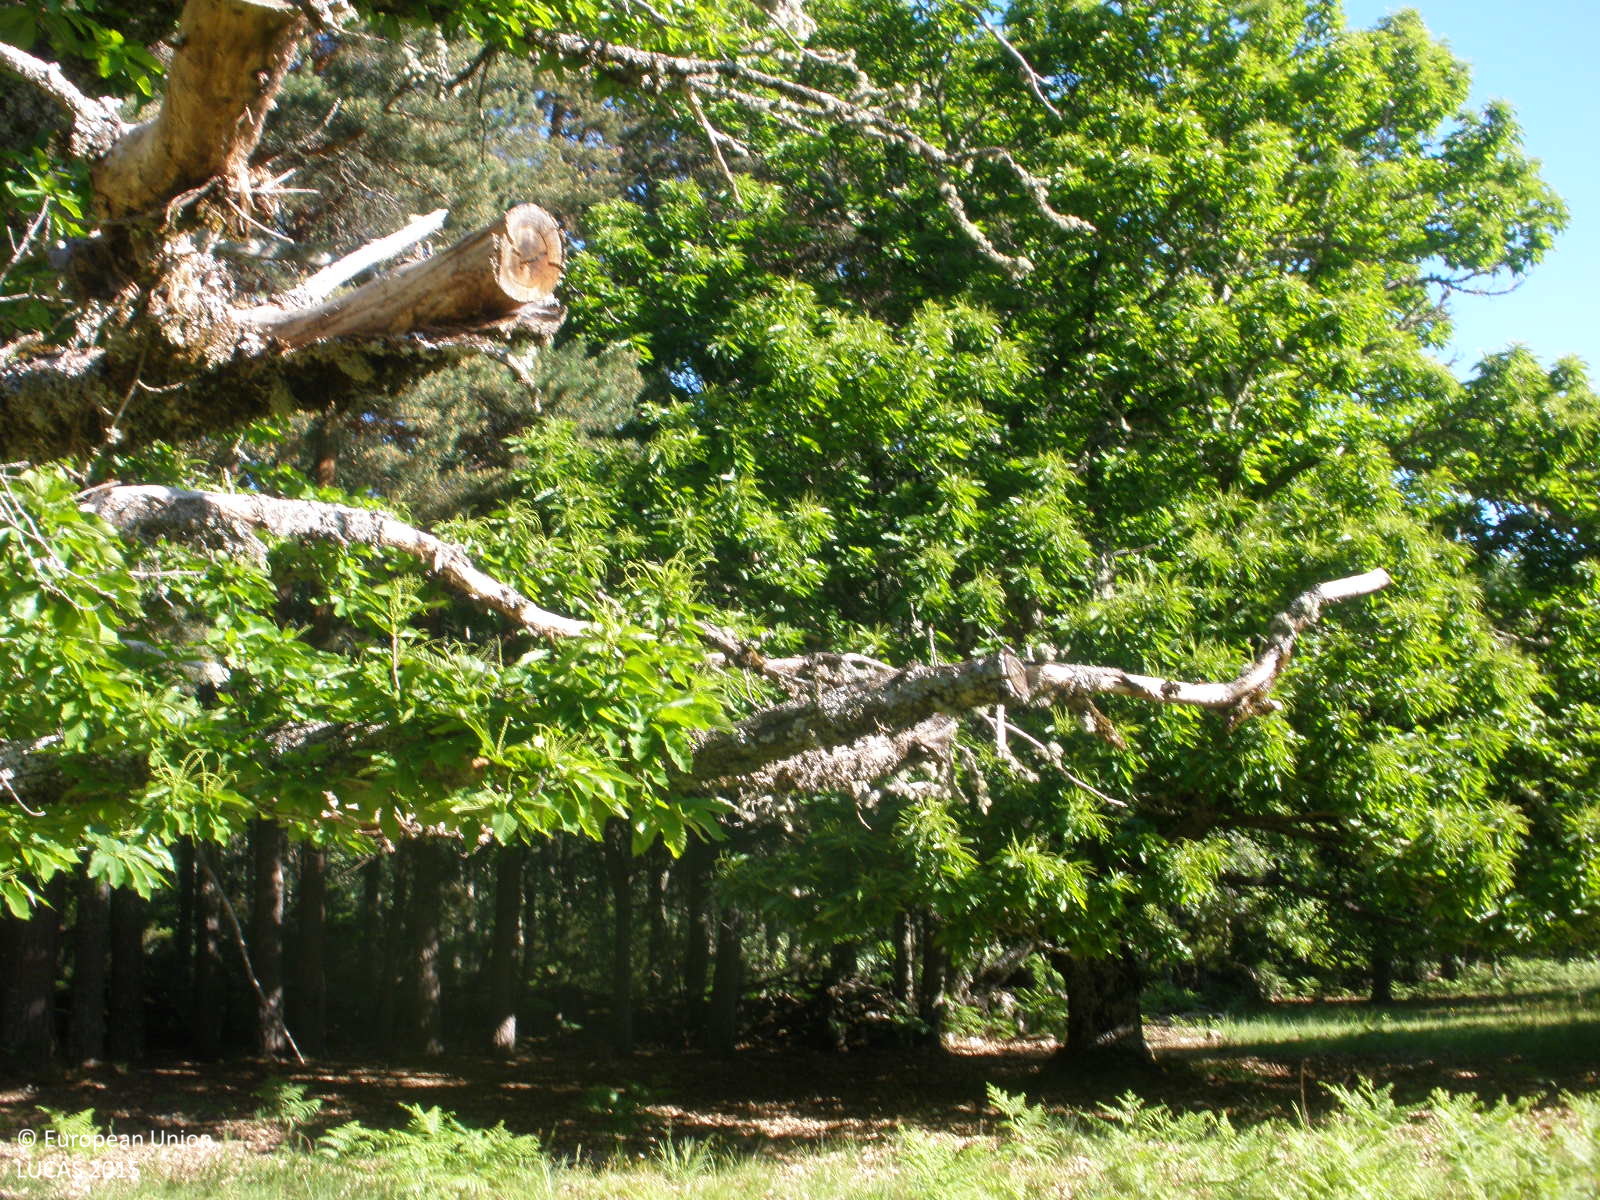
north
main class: Grassland
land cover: Grassland with sparse tree/shrub cover
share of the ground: > 75 %
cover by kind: herbaceous plants 95 %, broadleaved forest trees 5 %
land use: Agriculture (excluding fallow land and kitchen gardens)
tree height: > 5 m
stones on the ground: < 10 %
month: May
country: ES
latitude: 40.5213
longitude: -6.1449
